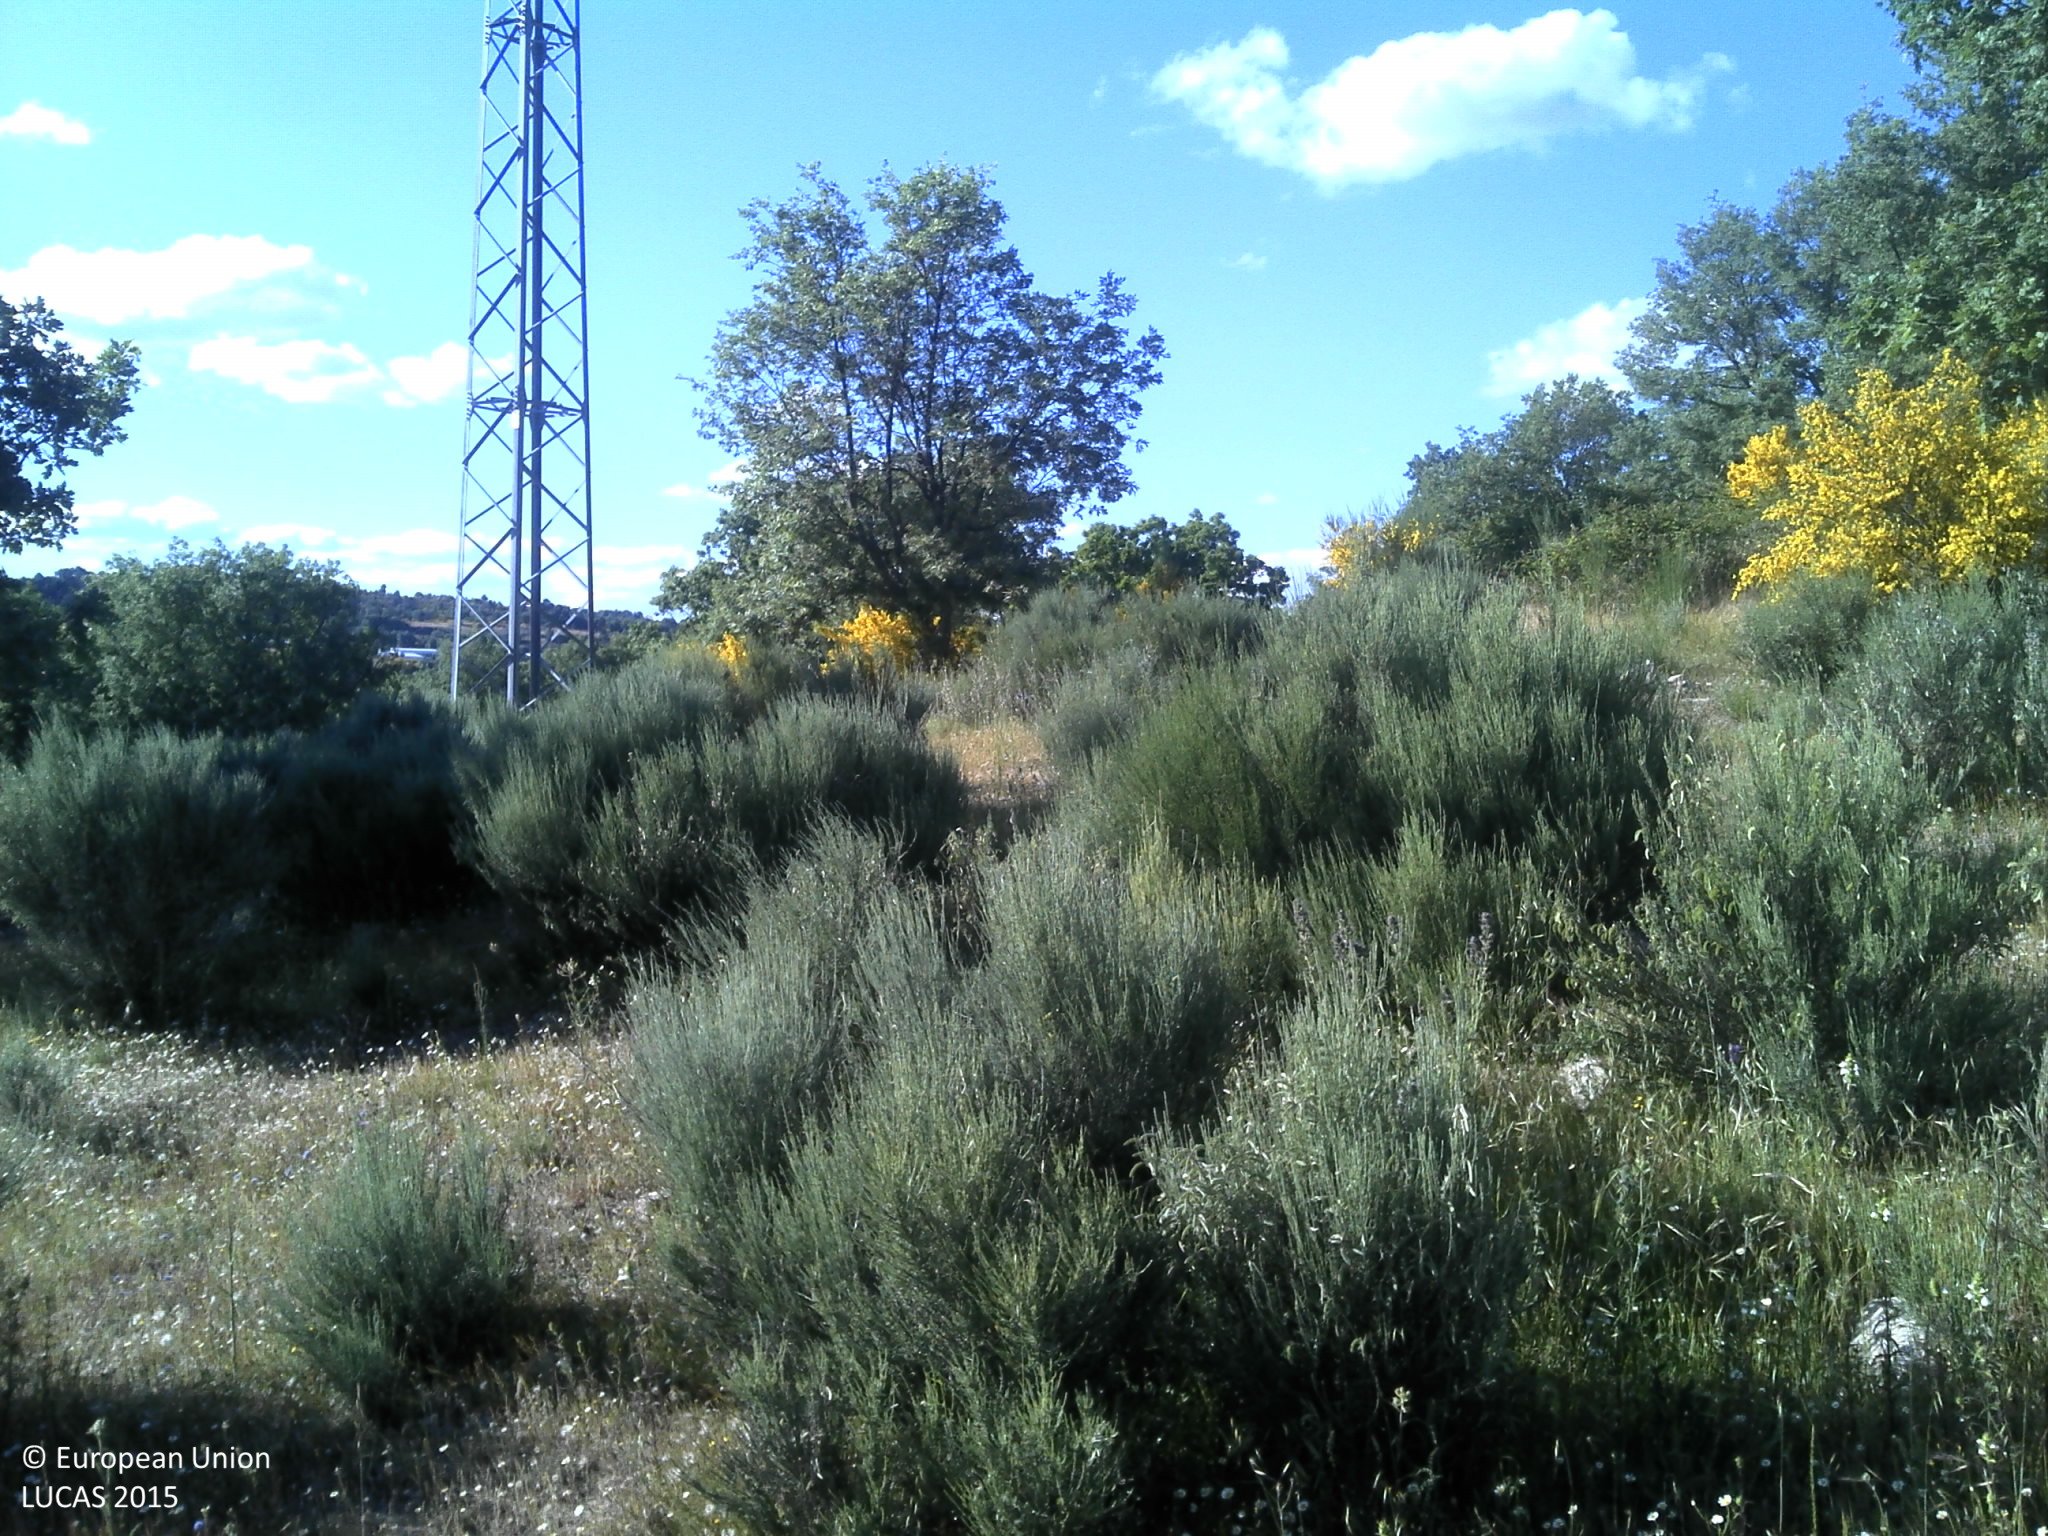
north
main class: Grassland
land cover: Grassland with sparse tree/shrub cover
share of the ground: 50 - 75 %
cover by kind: herbaceous plants 70 %, shrubs 10 %, unconsolidated bare surface 10 %, broadleaved forest trees 5 %
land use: Agriculture (excluding fallow land and kitchen gardens)
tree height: > 5 m
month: May
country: PT
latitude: 40.5582
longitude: -7.2177
